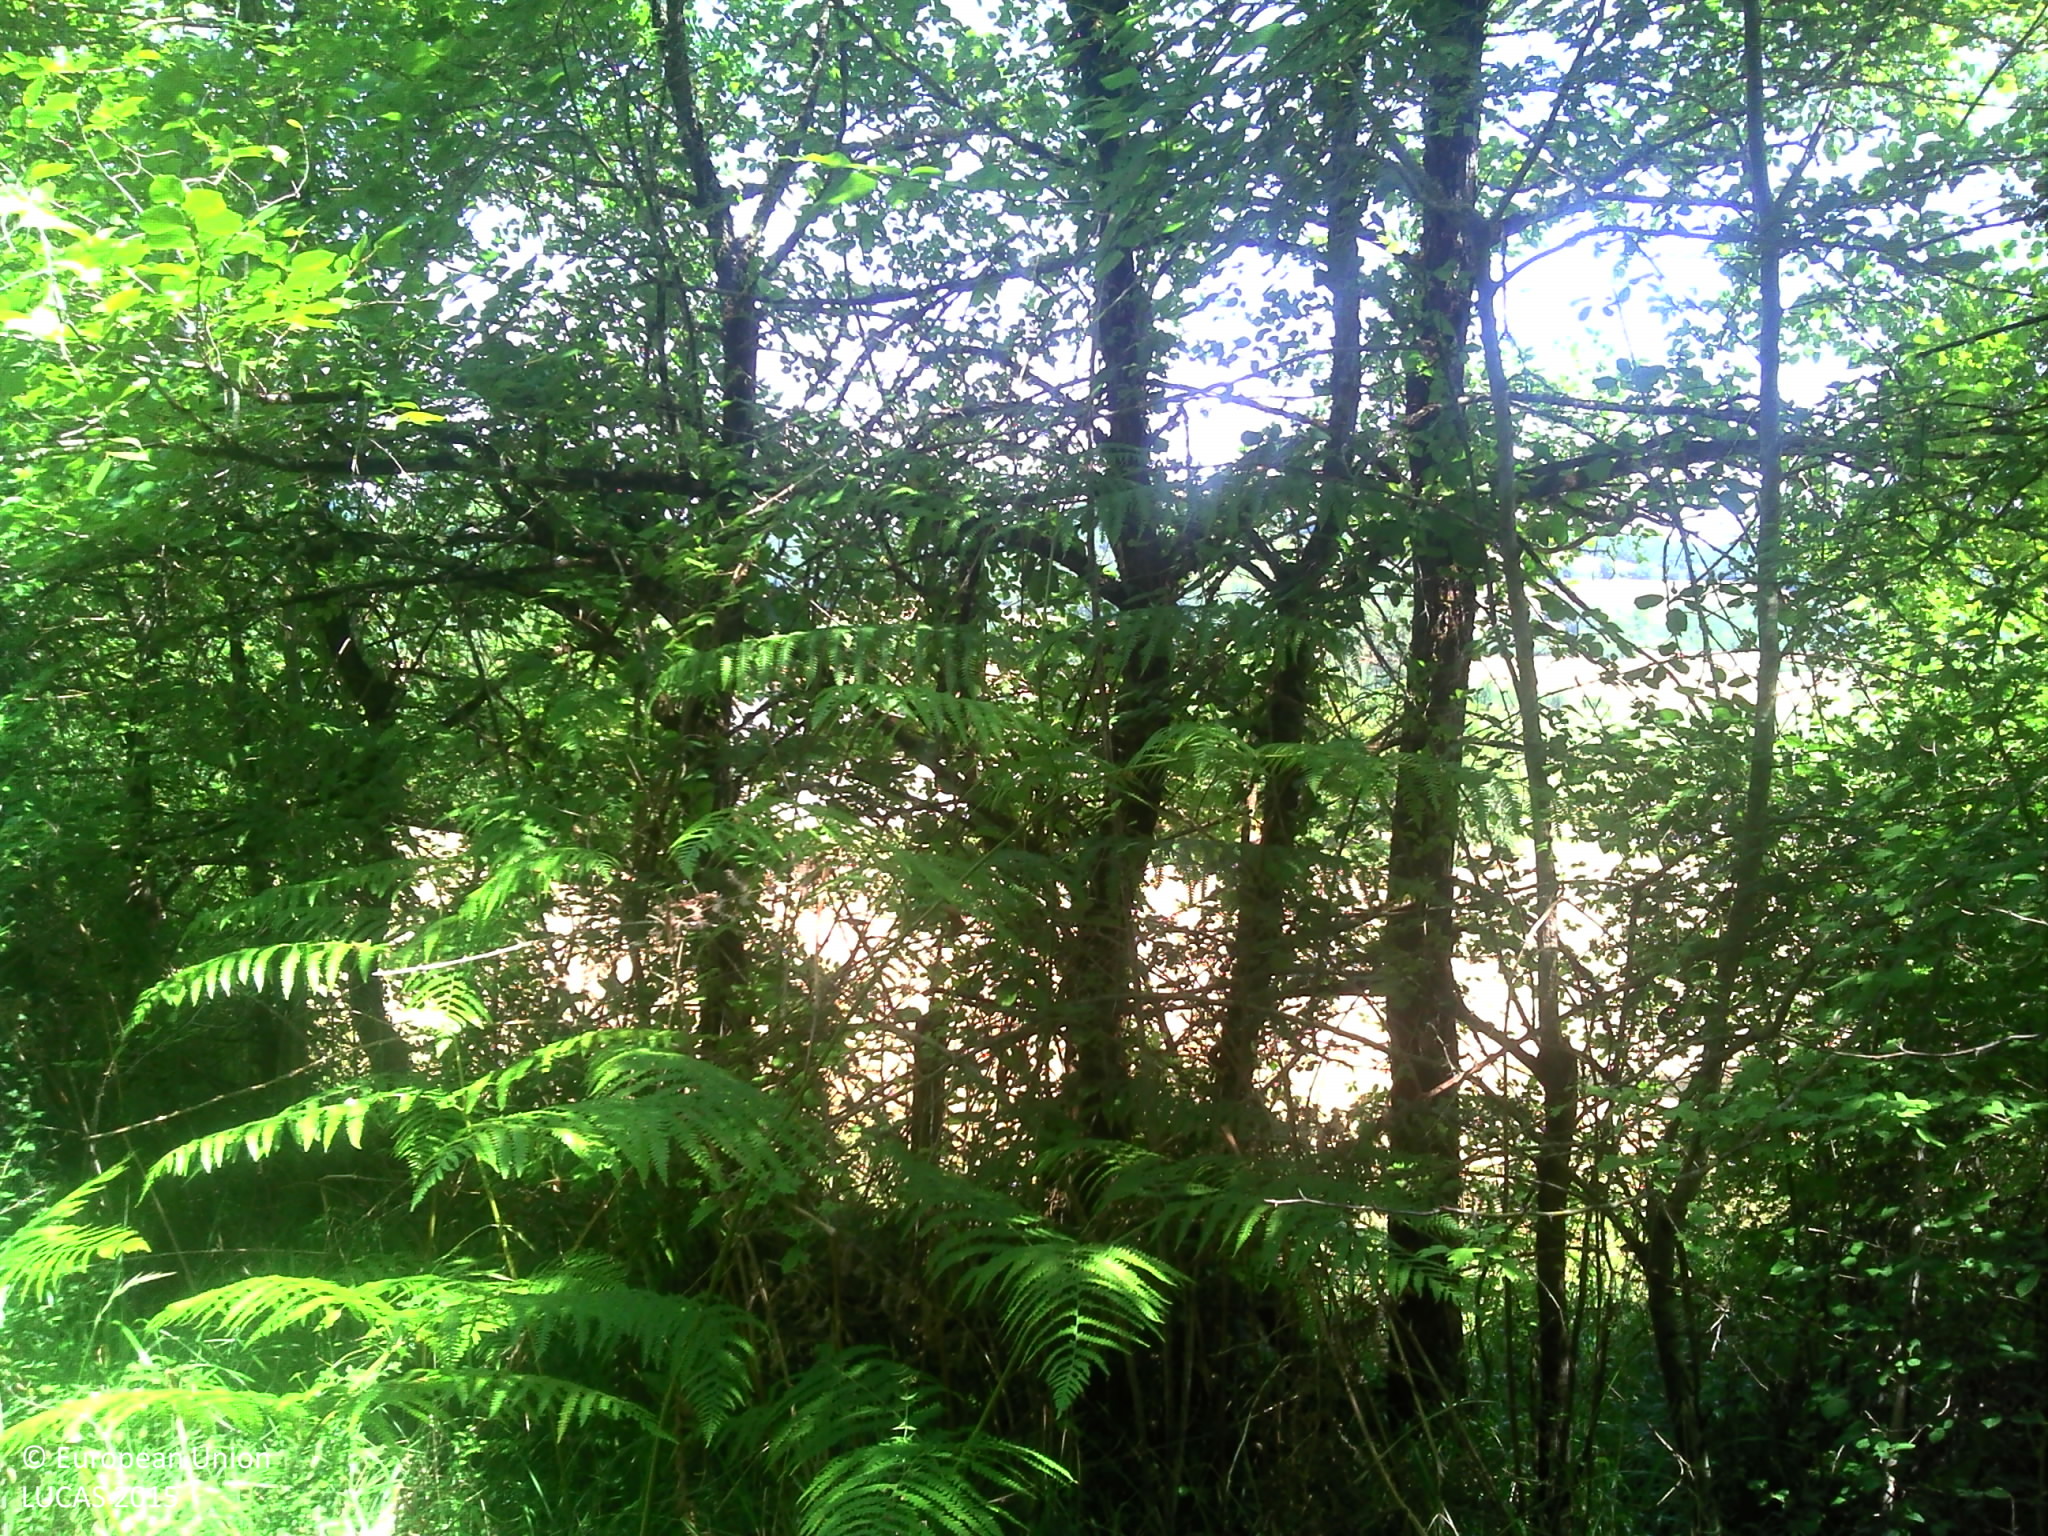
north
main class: Woodland
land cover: Broadleaved woodland
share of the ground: > 75 %
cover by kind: broadleaved forest trees 95 %, coniferous forest trees 5 %
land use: Semi-natural and natural areas not in use
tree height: < 5 m
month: June
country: FR
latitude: 44.1860
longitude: 0.9017
